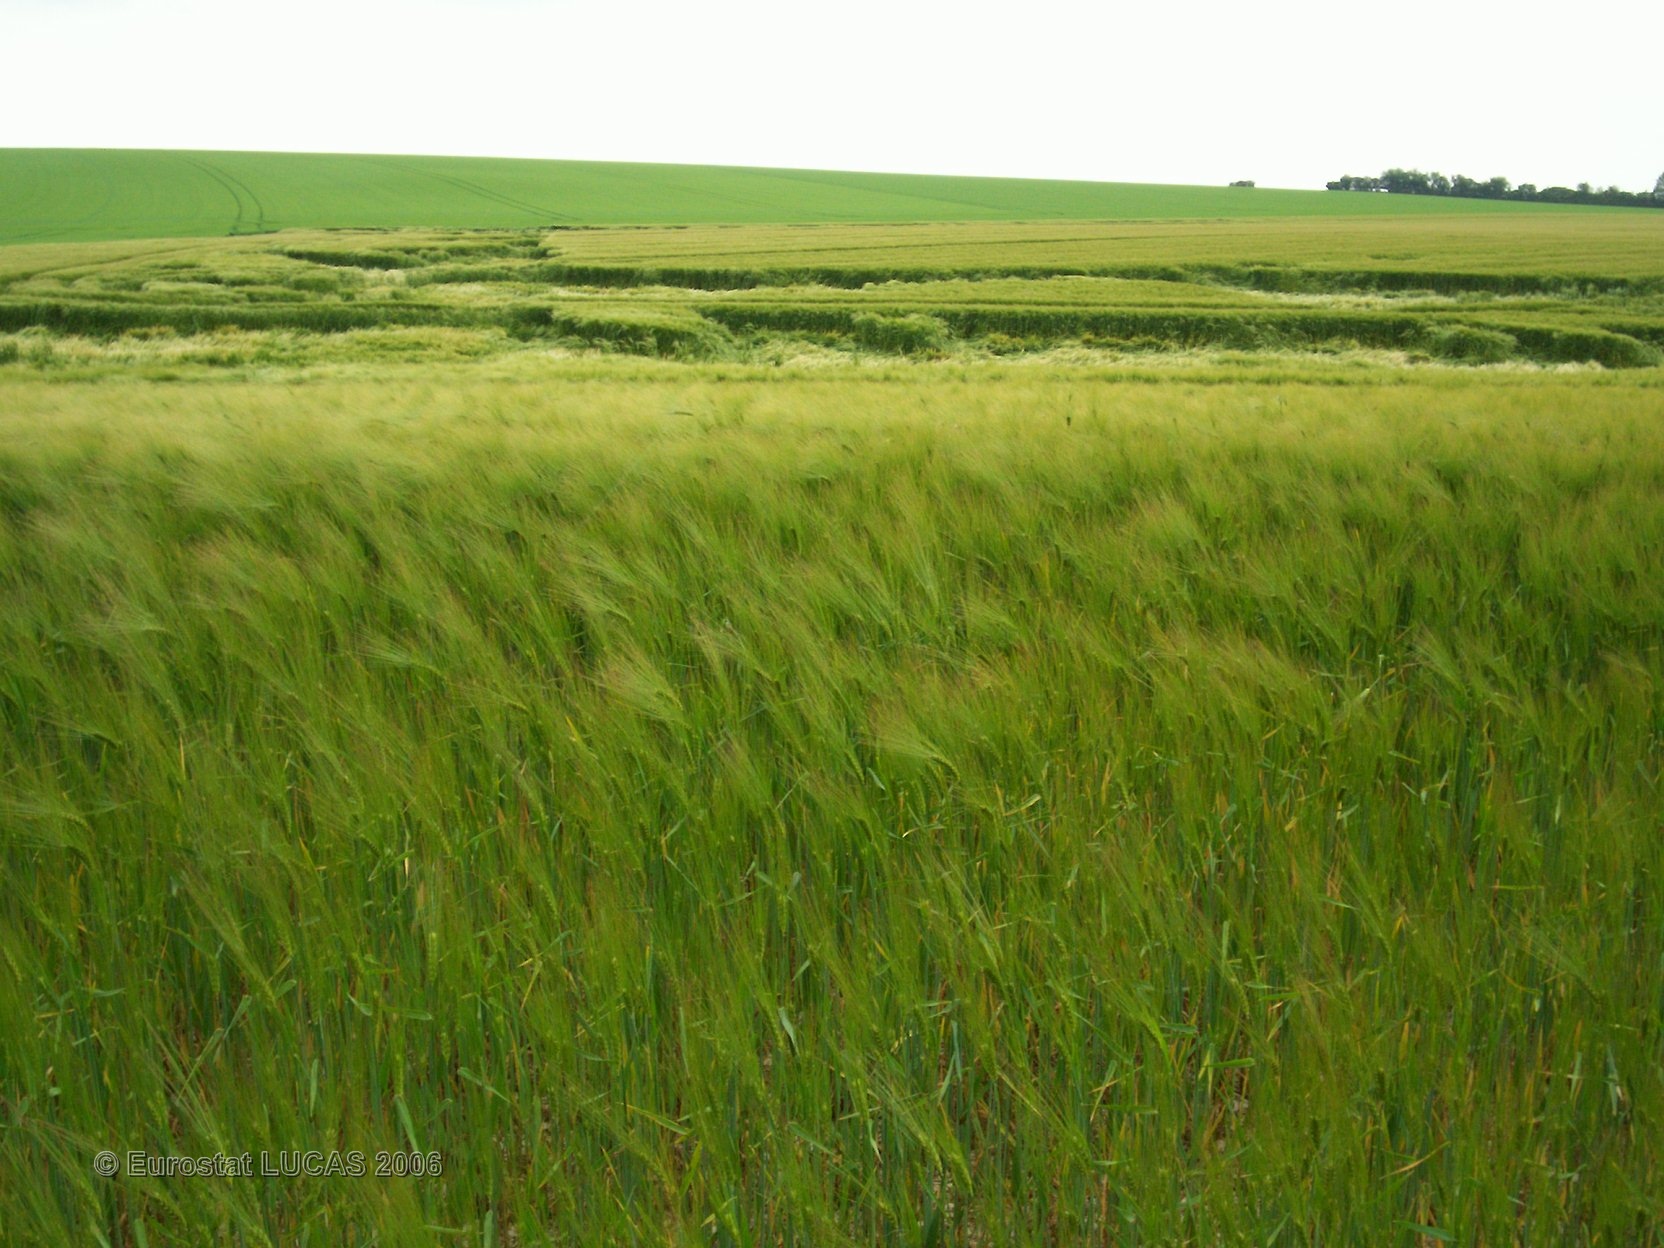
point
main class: Cropland
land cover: Barley
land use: Agriculture (excluding fallow land and kitchen gardens)
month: June
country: FR
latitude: 48.6785
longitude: 4.4420
